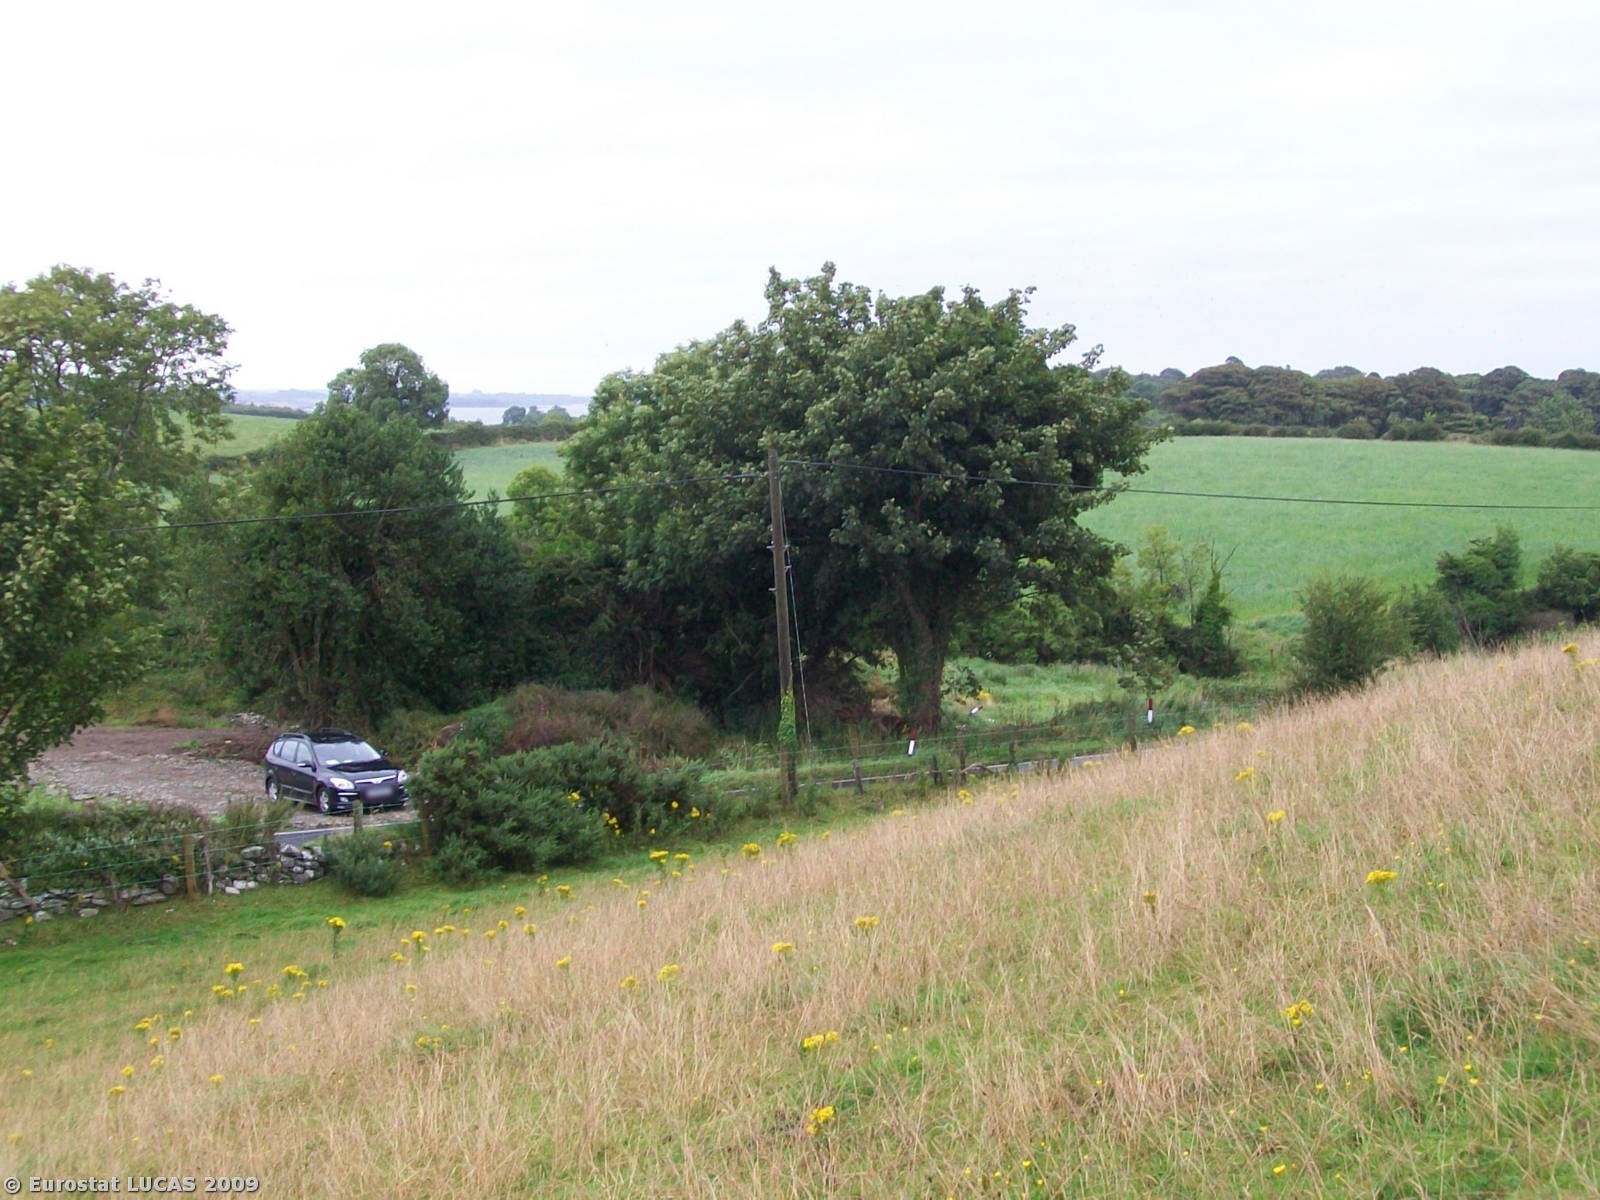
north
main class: Grassland
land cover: Grassland without tree/shrub cover
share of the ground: > 75 %
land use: Agriculture (excluding fallow land and kitchen gardens)
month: August
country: GB
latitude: 54.3590
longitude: -5.6272
